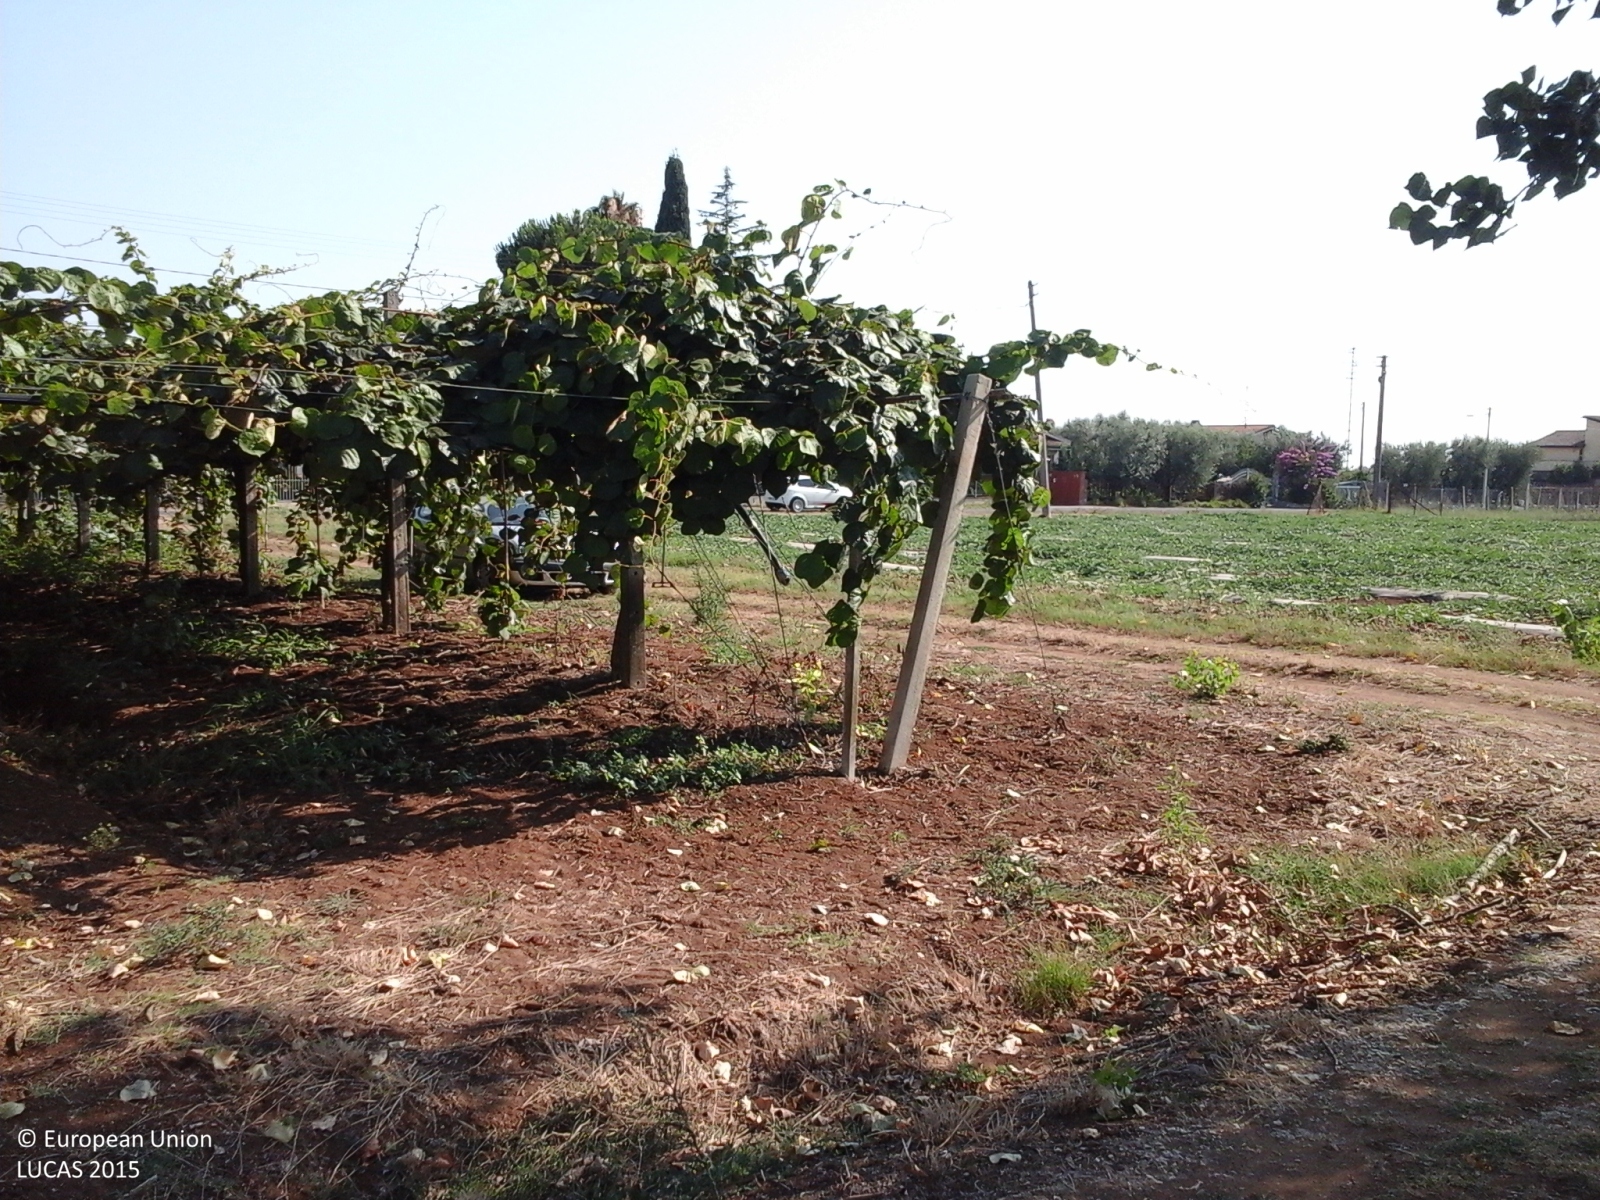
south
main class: Cropland
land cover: Other fruit trees and berries
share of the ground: > 75 %
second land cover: Grassland without tree/shrub cover
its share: > 75 %
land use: Agriculture (excluding fallow land and kitchen gardens)
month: July
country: IT
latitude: 41.5659
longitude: 12.8309
